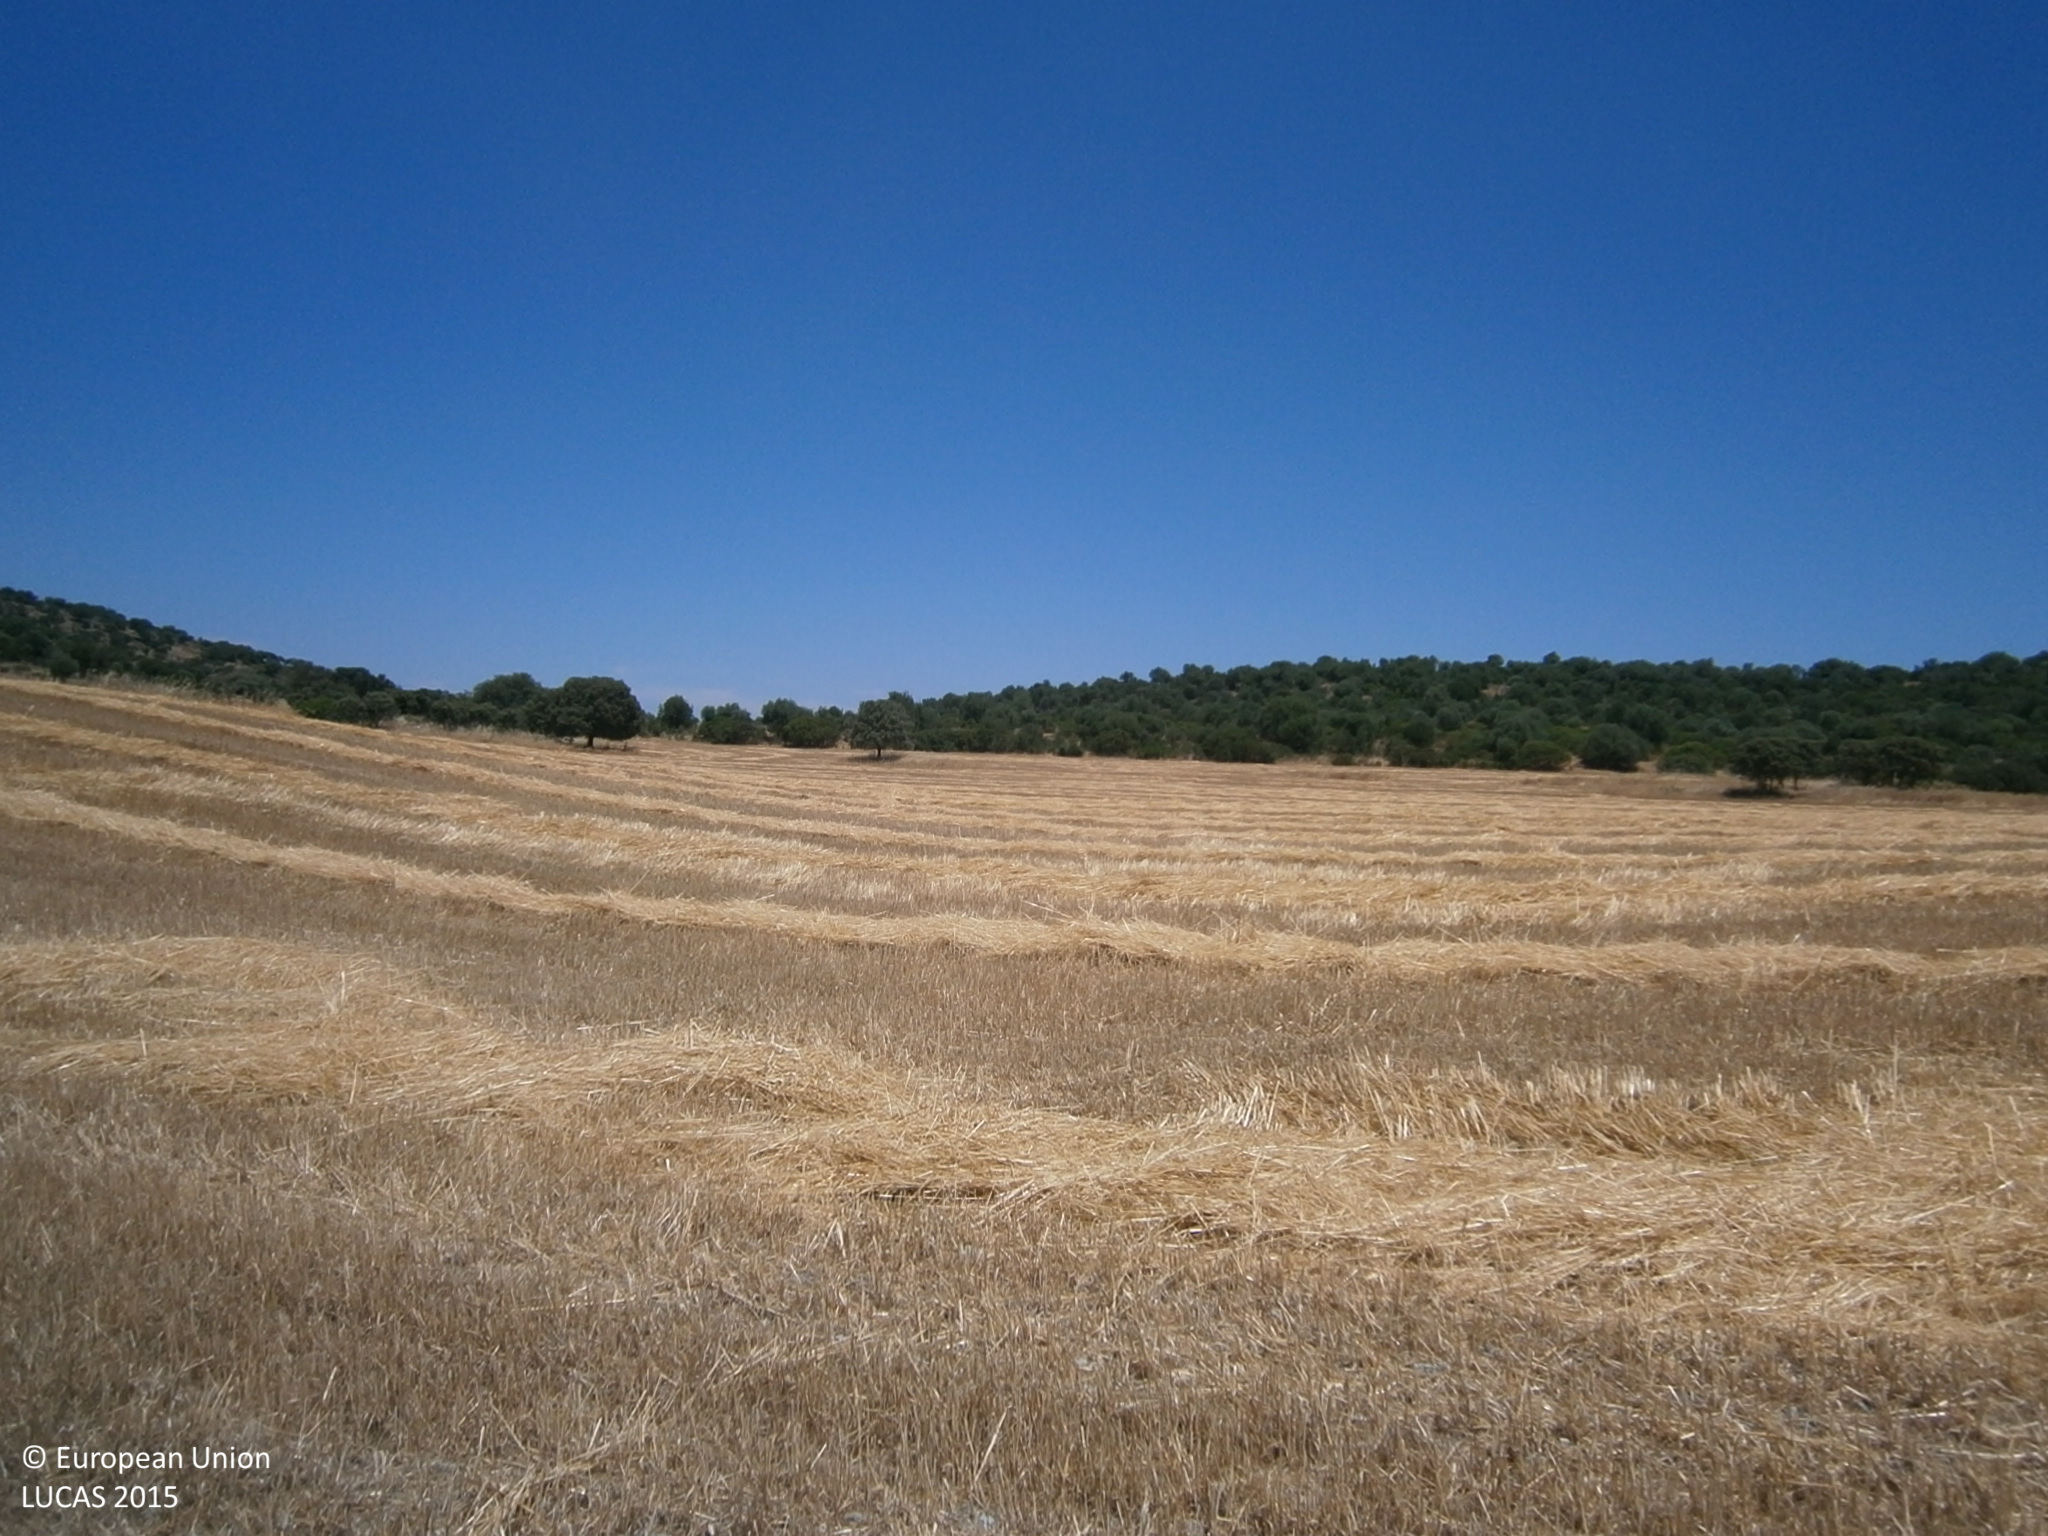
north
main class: Cropland
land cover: Oats
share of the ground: > 75 %
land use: Agriculture (excluding fallow land and kitchen gardens)
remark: Harvested field
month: June
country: ES
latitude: 38.6561
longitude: -6.9224
